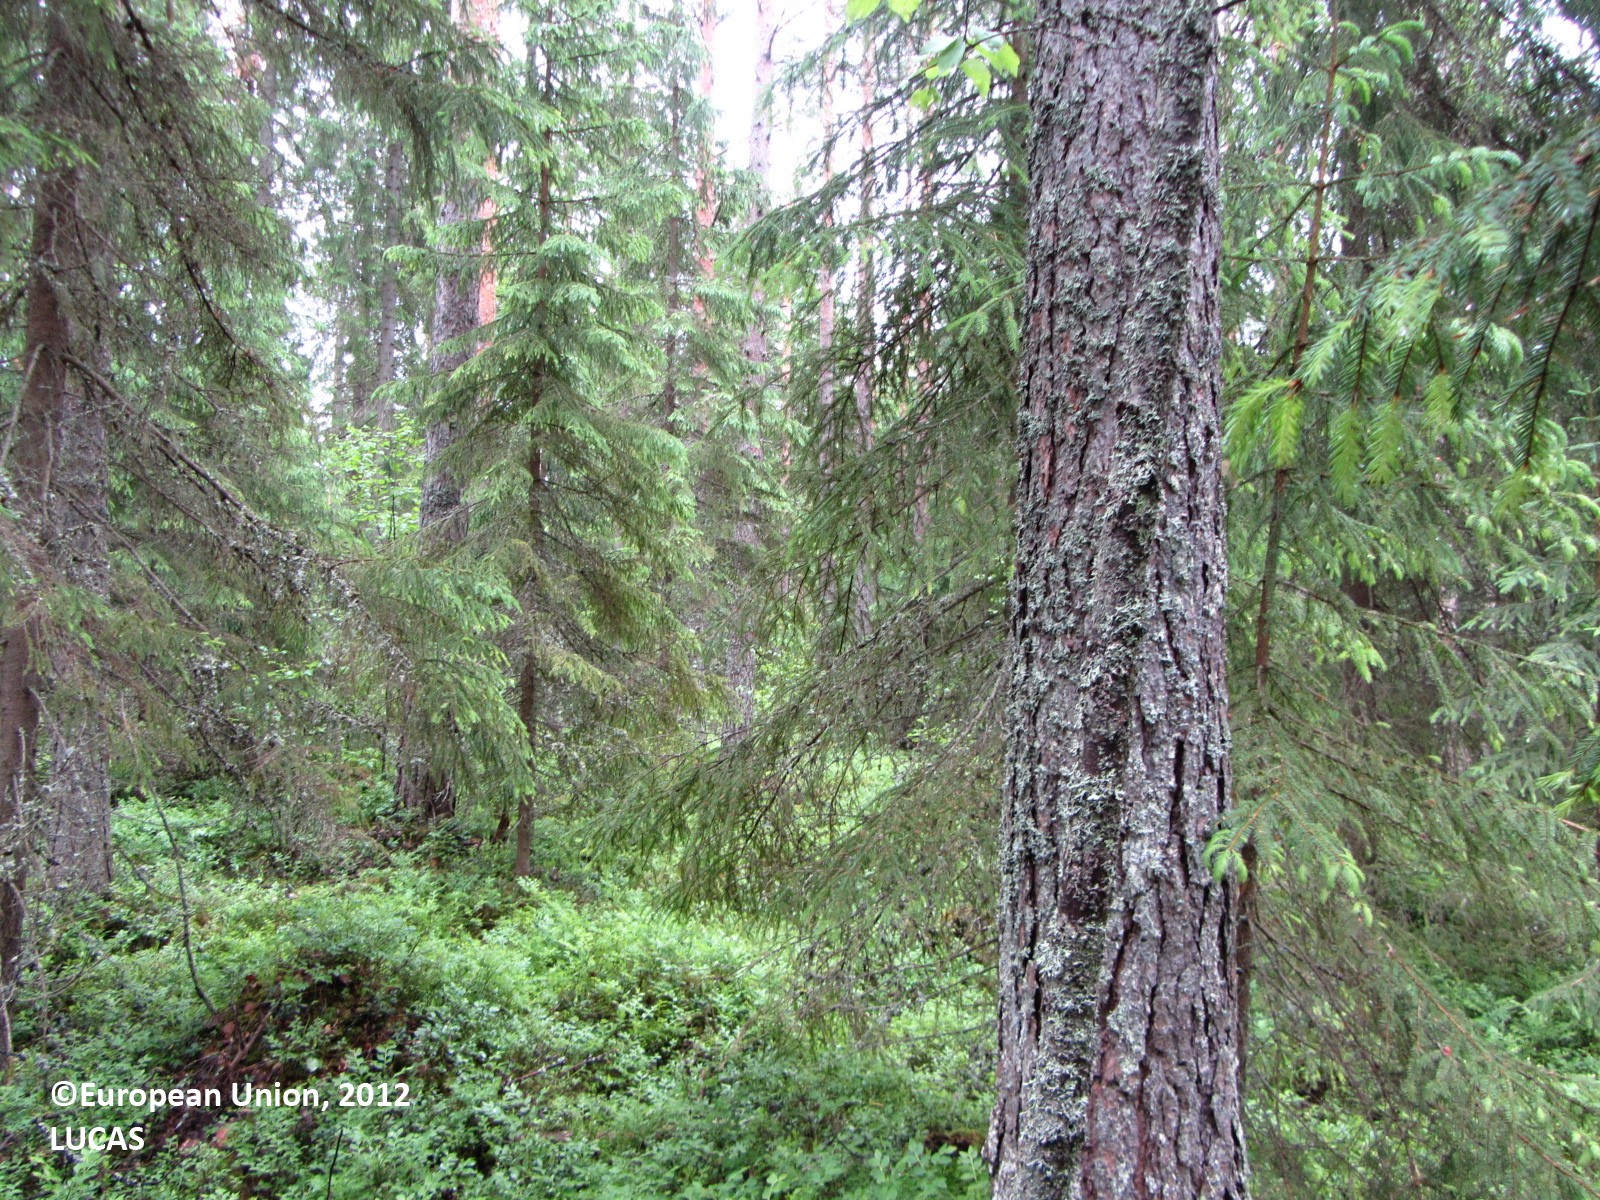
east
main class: Woodland
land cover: Other coniferous woodland
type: boreal forest
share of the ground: > 75 %
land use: Amenities, museums, leisure
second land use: Forestry
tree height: > 5 m
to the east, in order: Other coniferous woodland; Spruce dominated mixed woodland; Shrubland with sparse tree cover; Spruce dominated mixed woodland; Broadleaved woodland; Spruce dominated mixed woodland; Shrubland with sparse tree cover; Spruce dominated mixed woodland; Shrubland with sparse tree cover; Electric lines; Spruce dominated mixed woodland
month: June
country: FI
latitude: 62.0160
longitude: 25.2209
